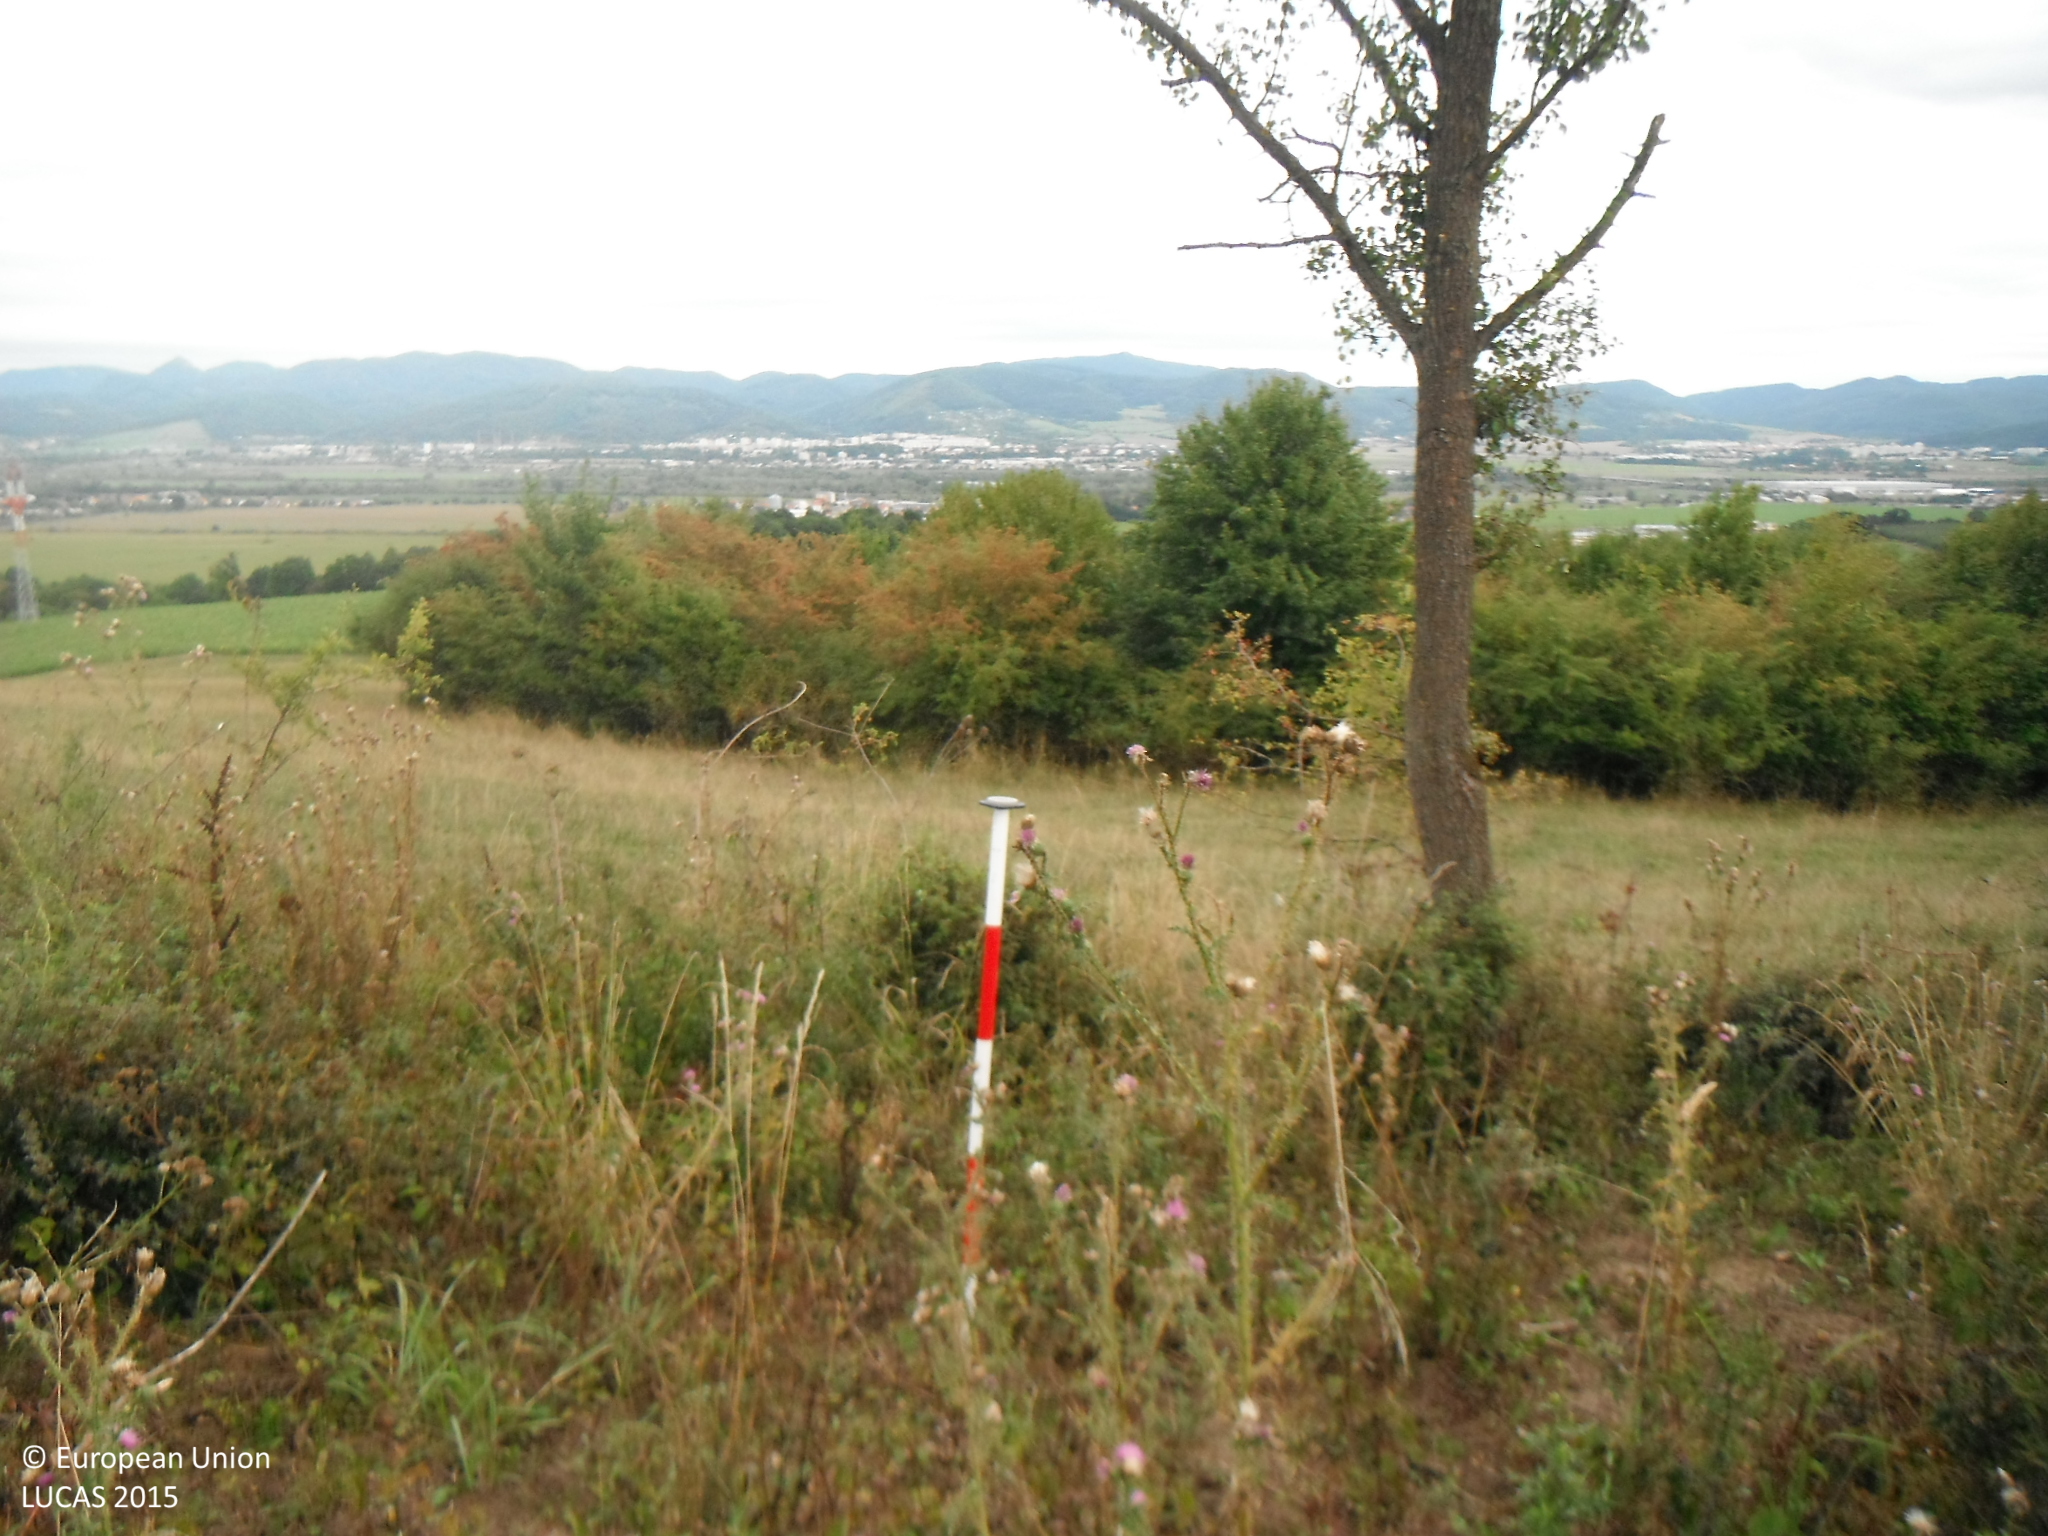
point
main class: Shrubland
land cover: Shrubland with sparse tree cover
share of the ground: 50 - 75 %
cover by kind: shrubs 50 %, herbaceous plants 45 %, broadleaved forest trees 5 %
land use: Abandoned areas
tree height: > 5 m
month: August
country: SK
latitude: 48.9905
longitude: 18.1192
